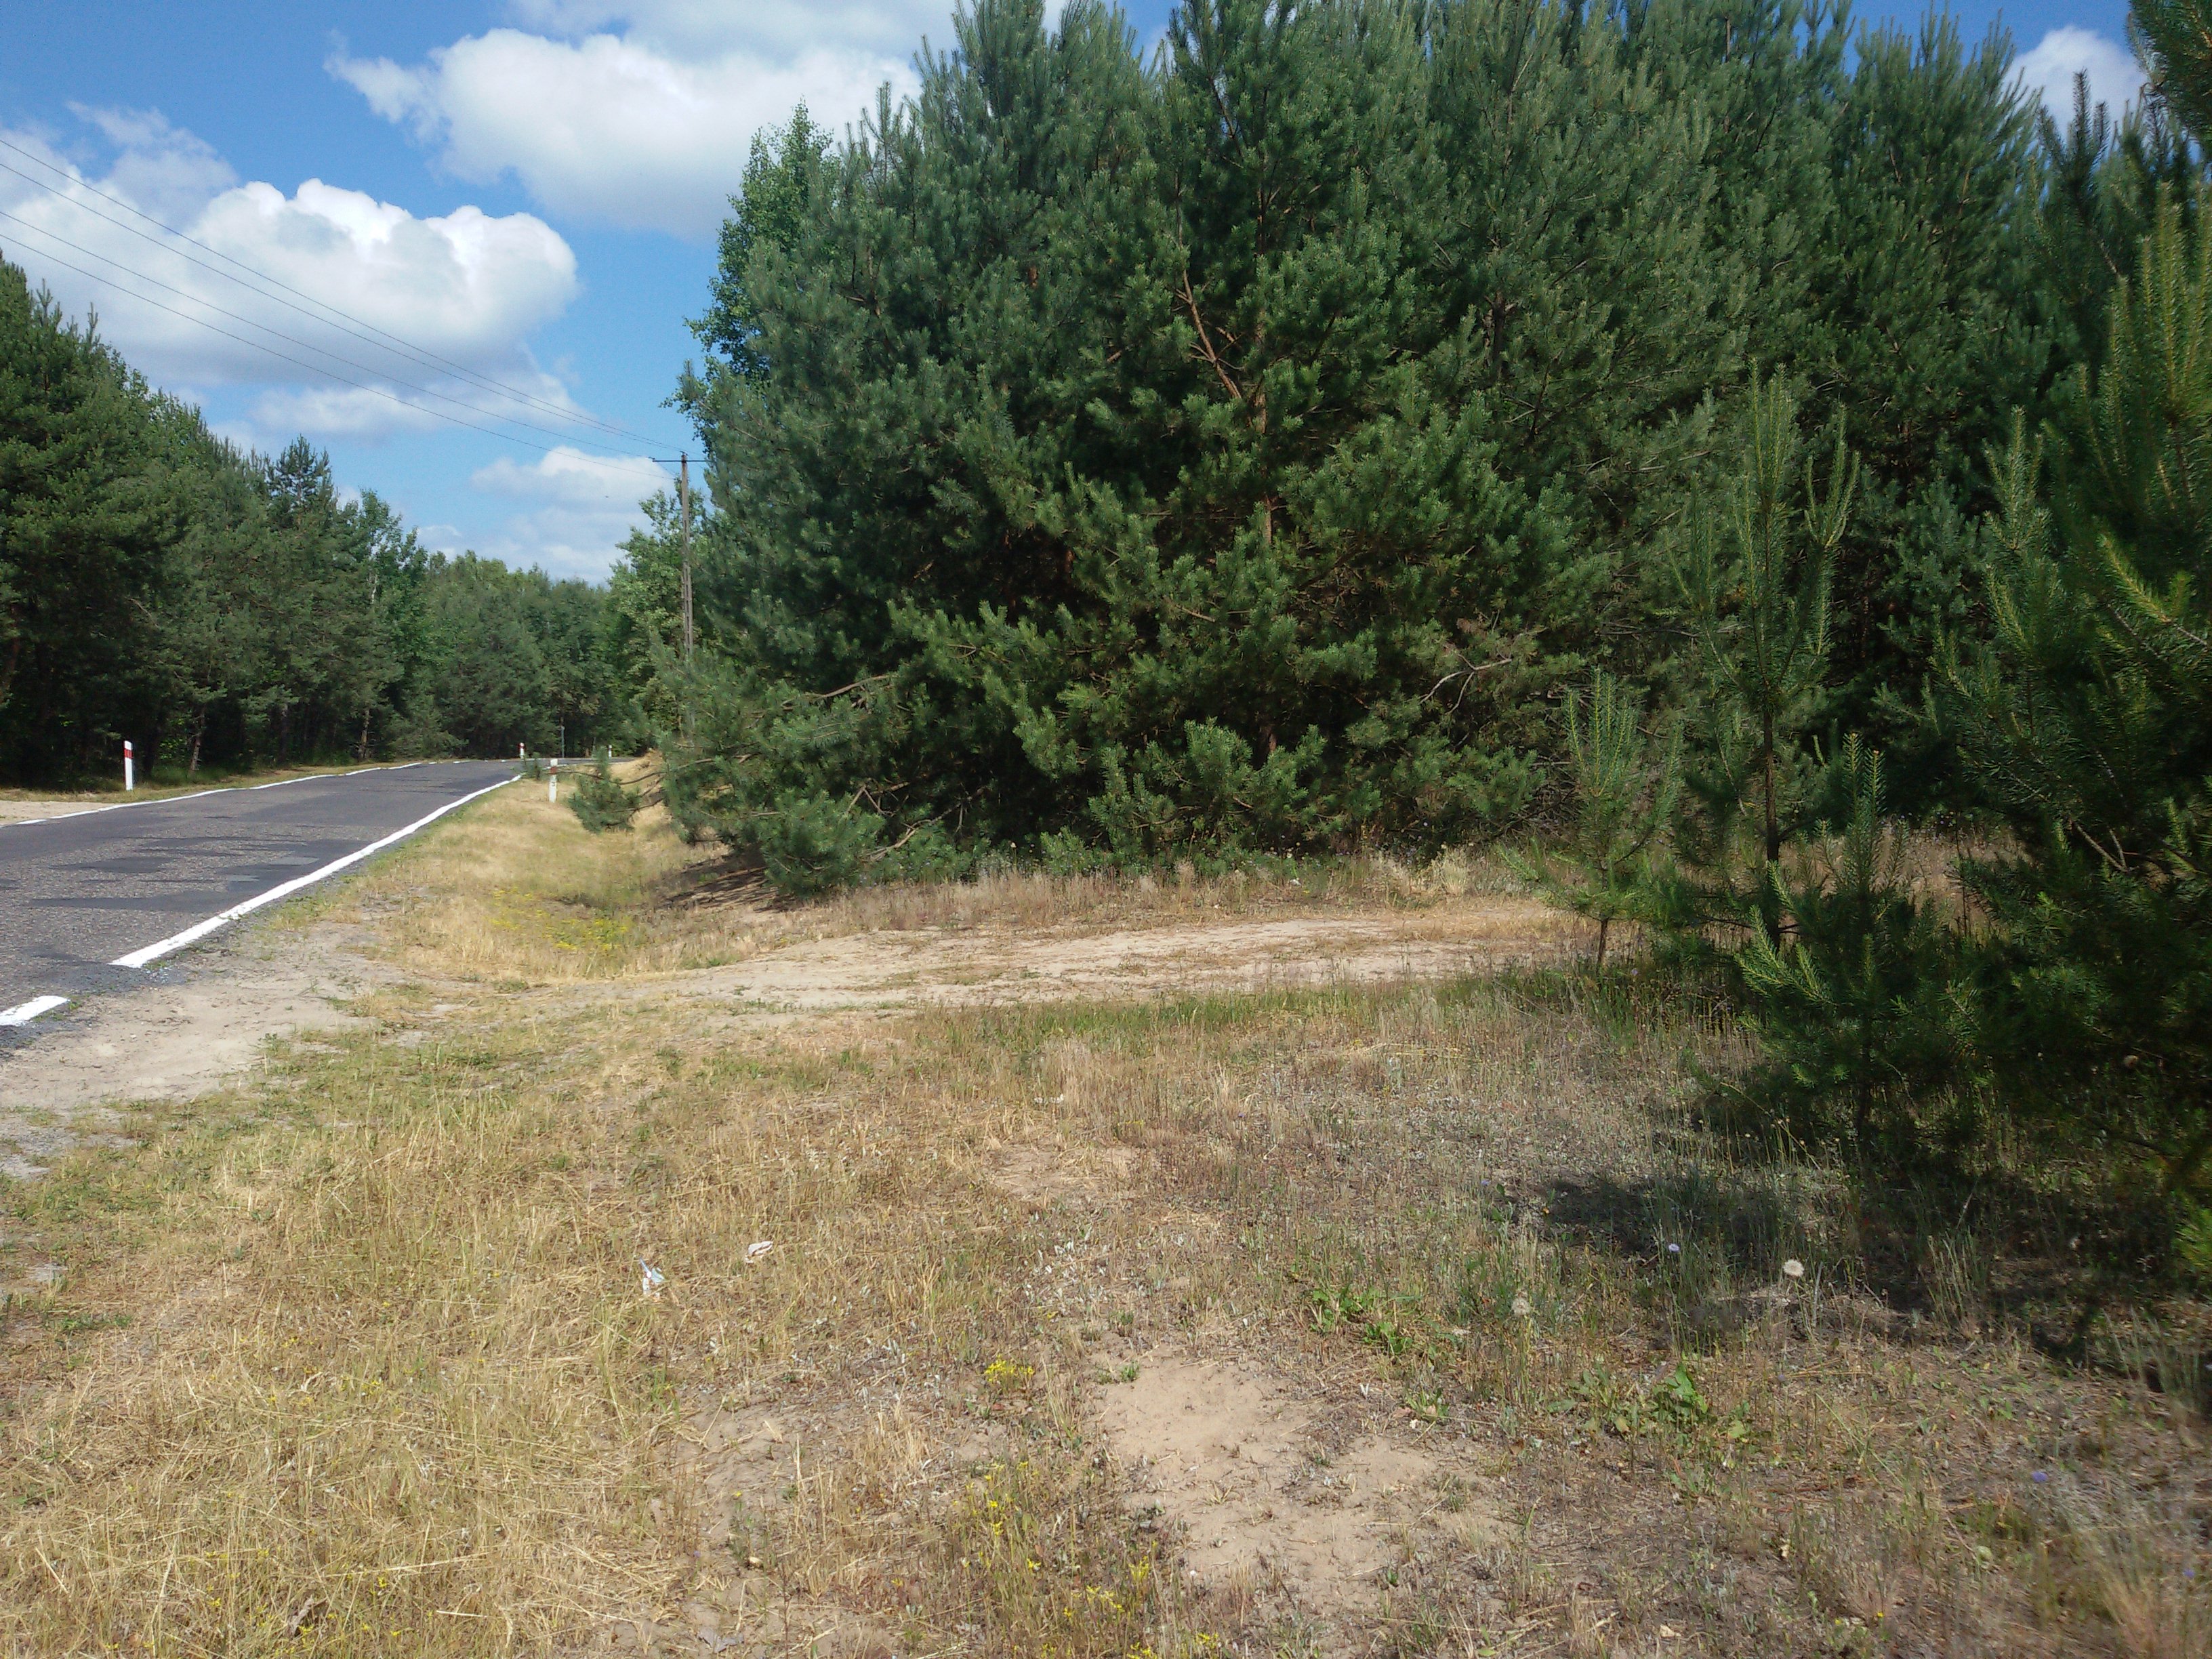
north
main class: Woodland
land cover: Spruce dominated coniferous woodland
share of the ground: > 75 %
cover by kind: coniferous forest trees 95 %, herbaceous plants 5 %
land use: Forestry
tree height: < 5 m
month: June
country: PL
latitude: 51.8277
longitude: 23.5952
